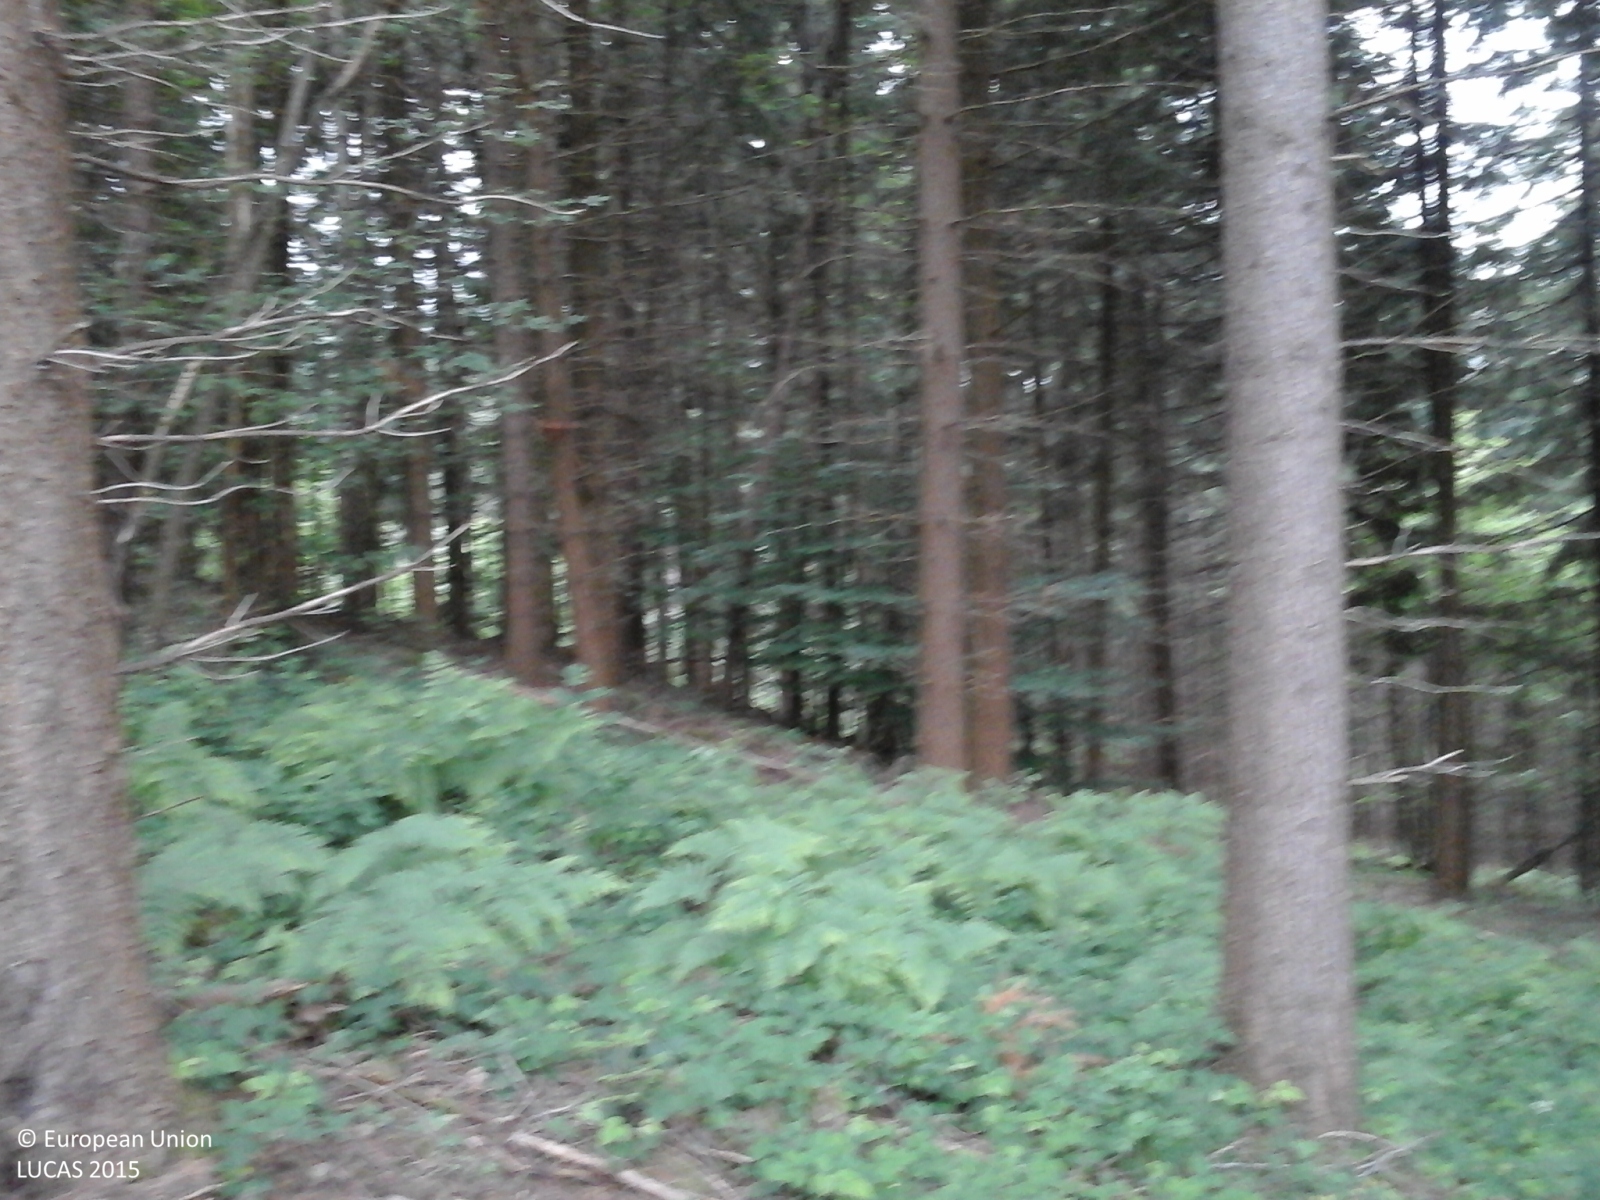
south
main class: Woodland
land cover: Other coniferous woodland
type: alpine coniferous forest
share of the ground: > 75 %
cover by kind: coniferous forest trees 75 %, broadleaved forest trees 25 %
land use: Forestry
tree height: > 5 m
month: May
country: IT
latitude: 43.7793
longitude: 11.5739
